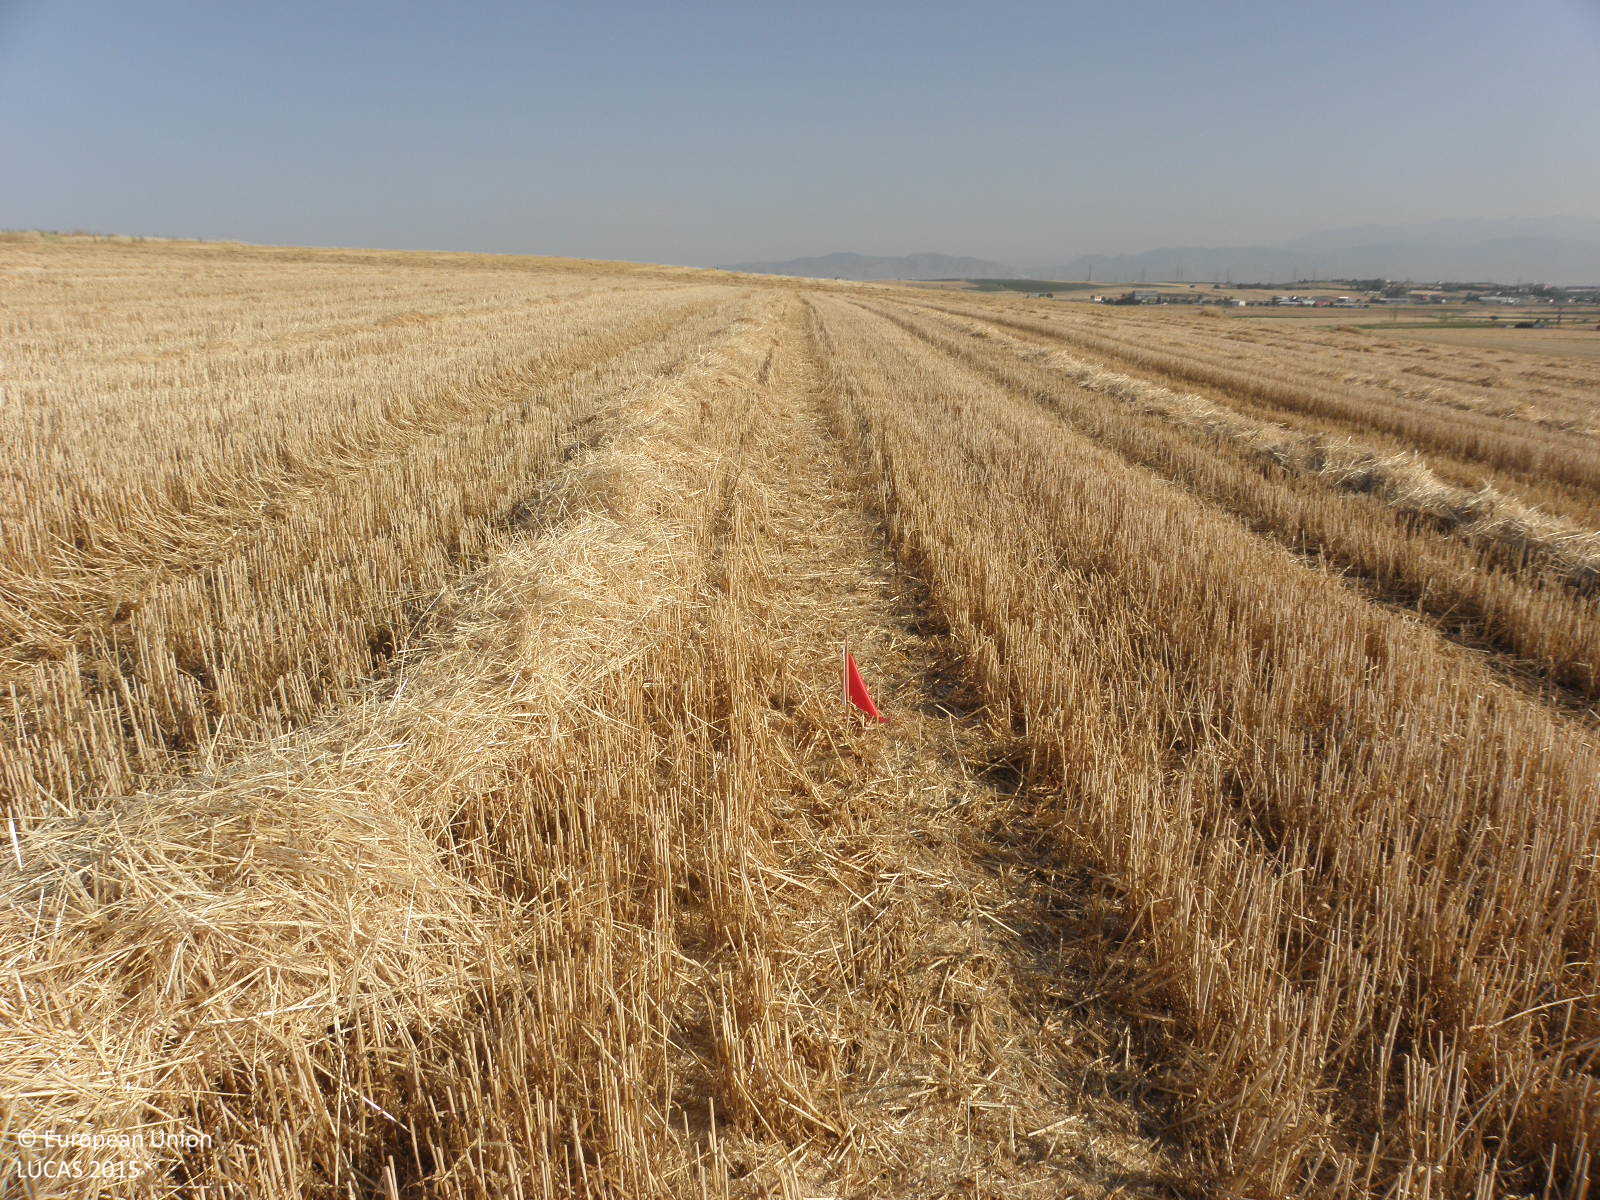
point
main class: Cropland
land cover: Durum wheat
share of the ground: > 75 %
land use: Agriculture (excluding fallow land and kitchen gardens)
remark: Harvested field
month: June
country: GR
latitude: 39.5706
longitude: 22.3861
